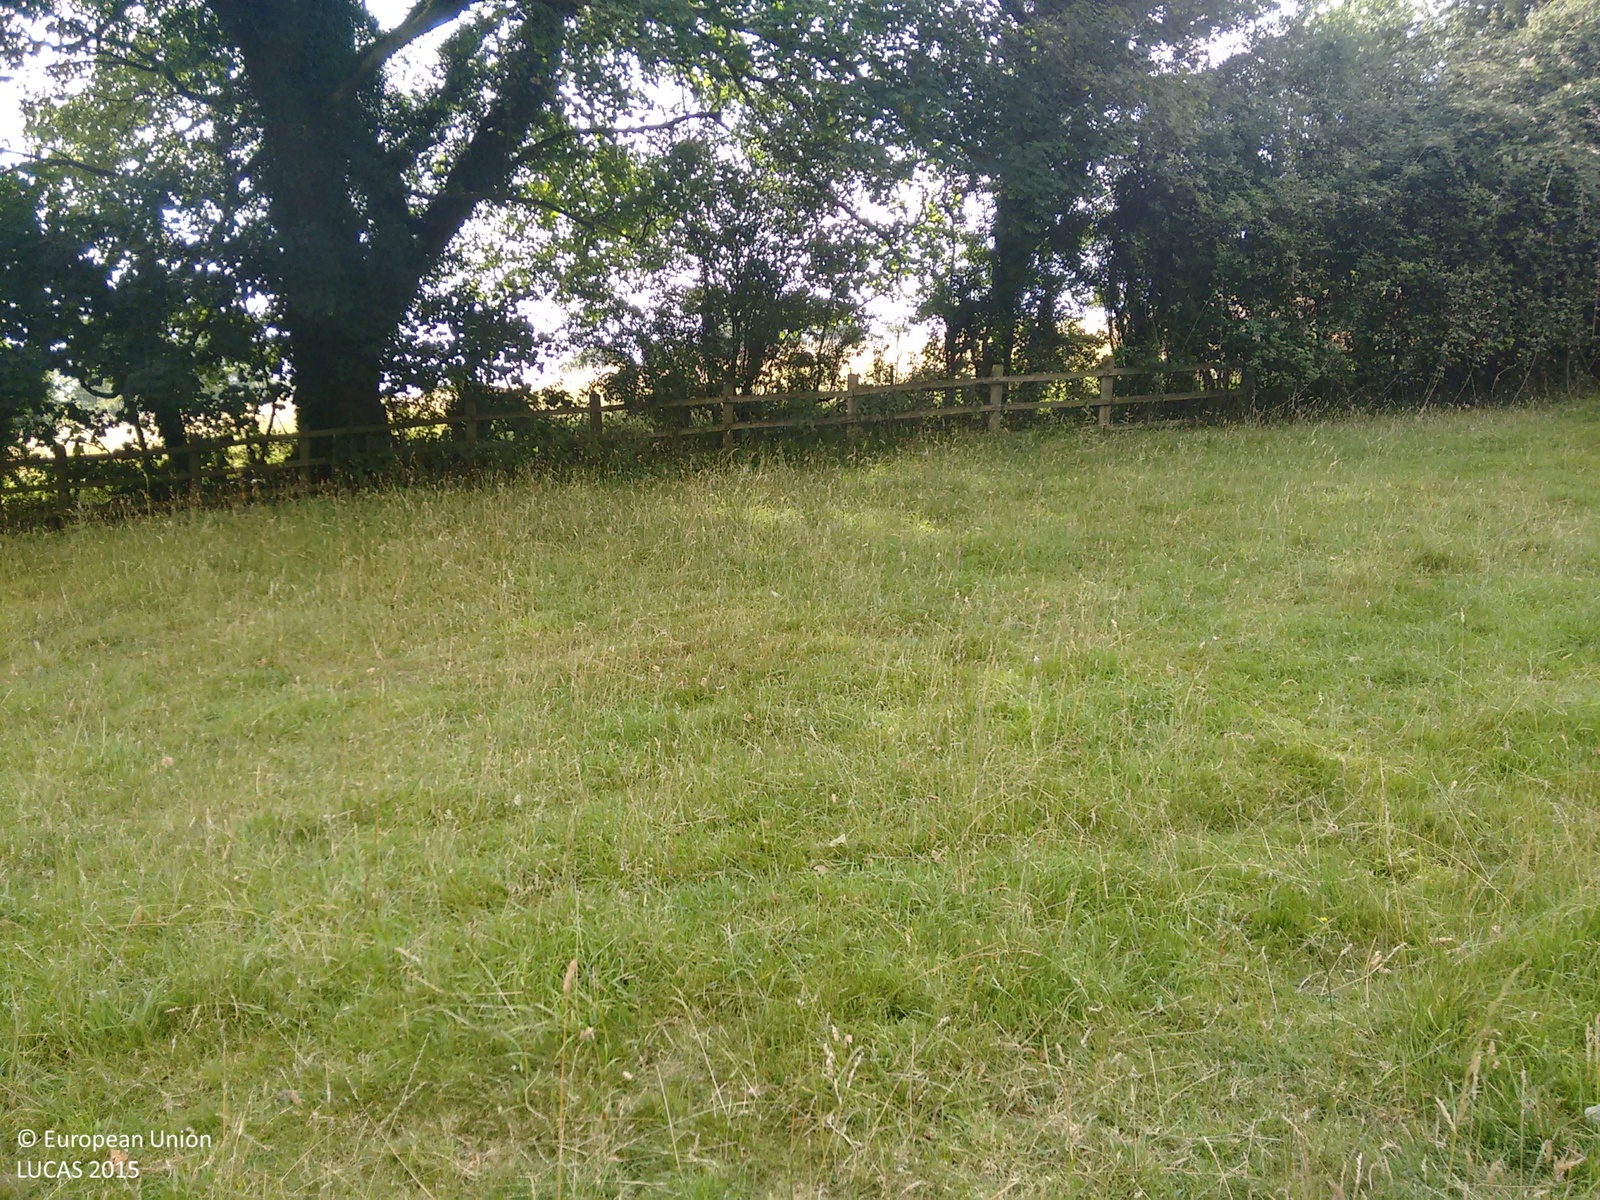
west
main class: Grassland
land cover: Grassland without tree/shrub cover
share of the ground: > 75 %
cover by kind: herbaceous plants 100 %
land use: Agriculture (excluding fallow land and kitchen gardens)
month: July
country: GB
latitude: 51.3955
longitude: -2.4110
